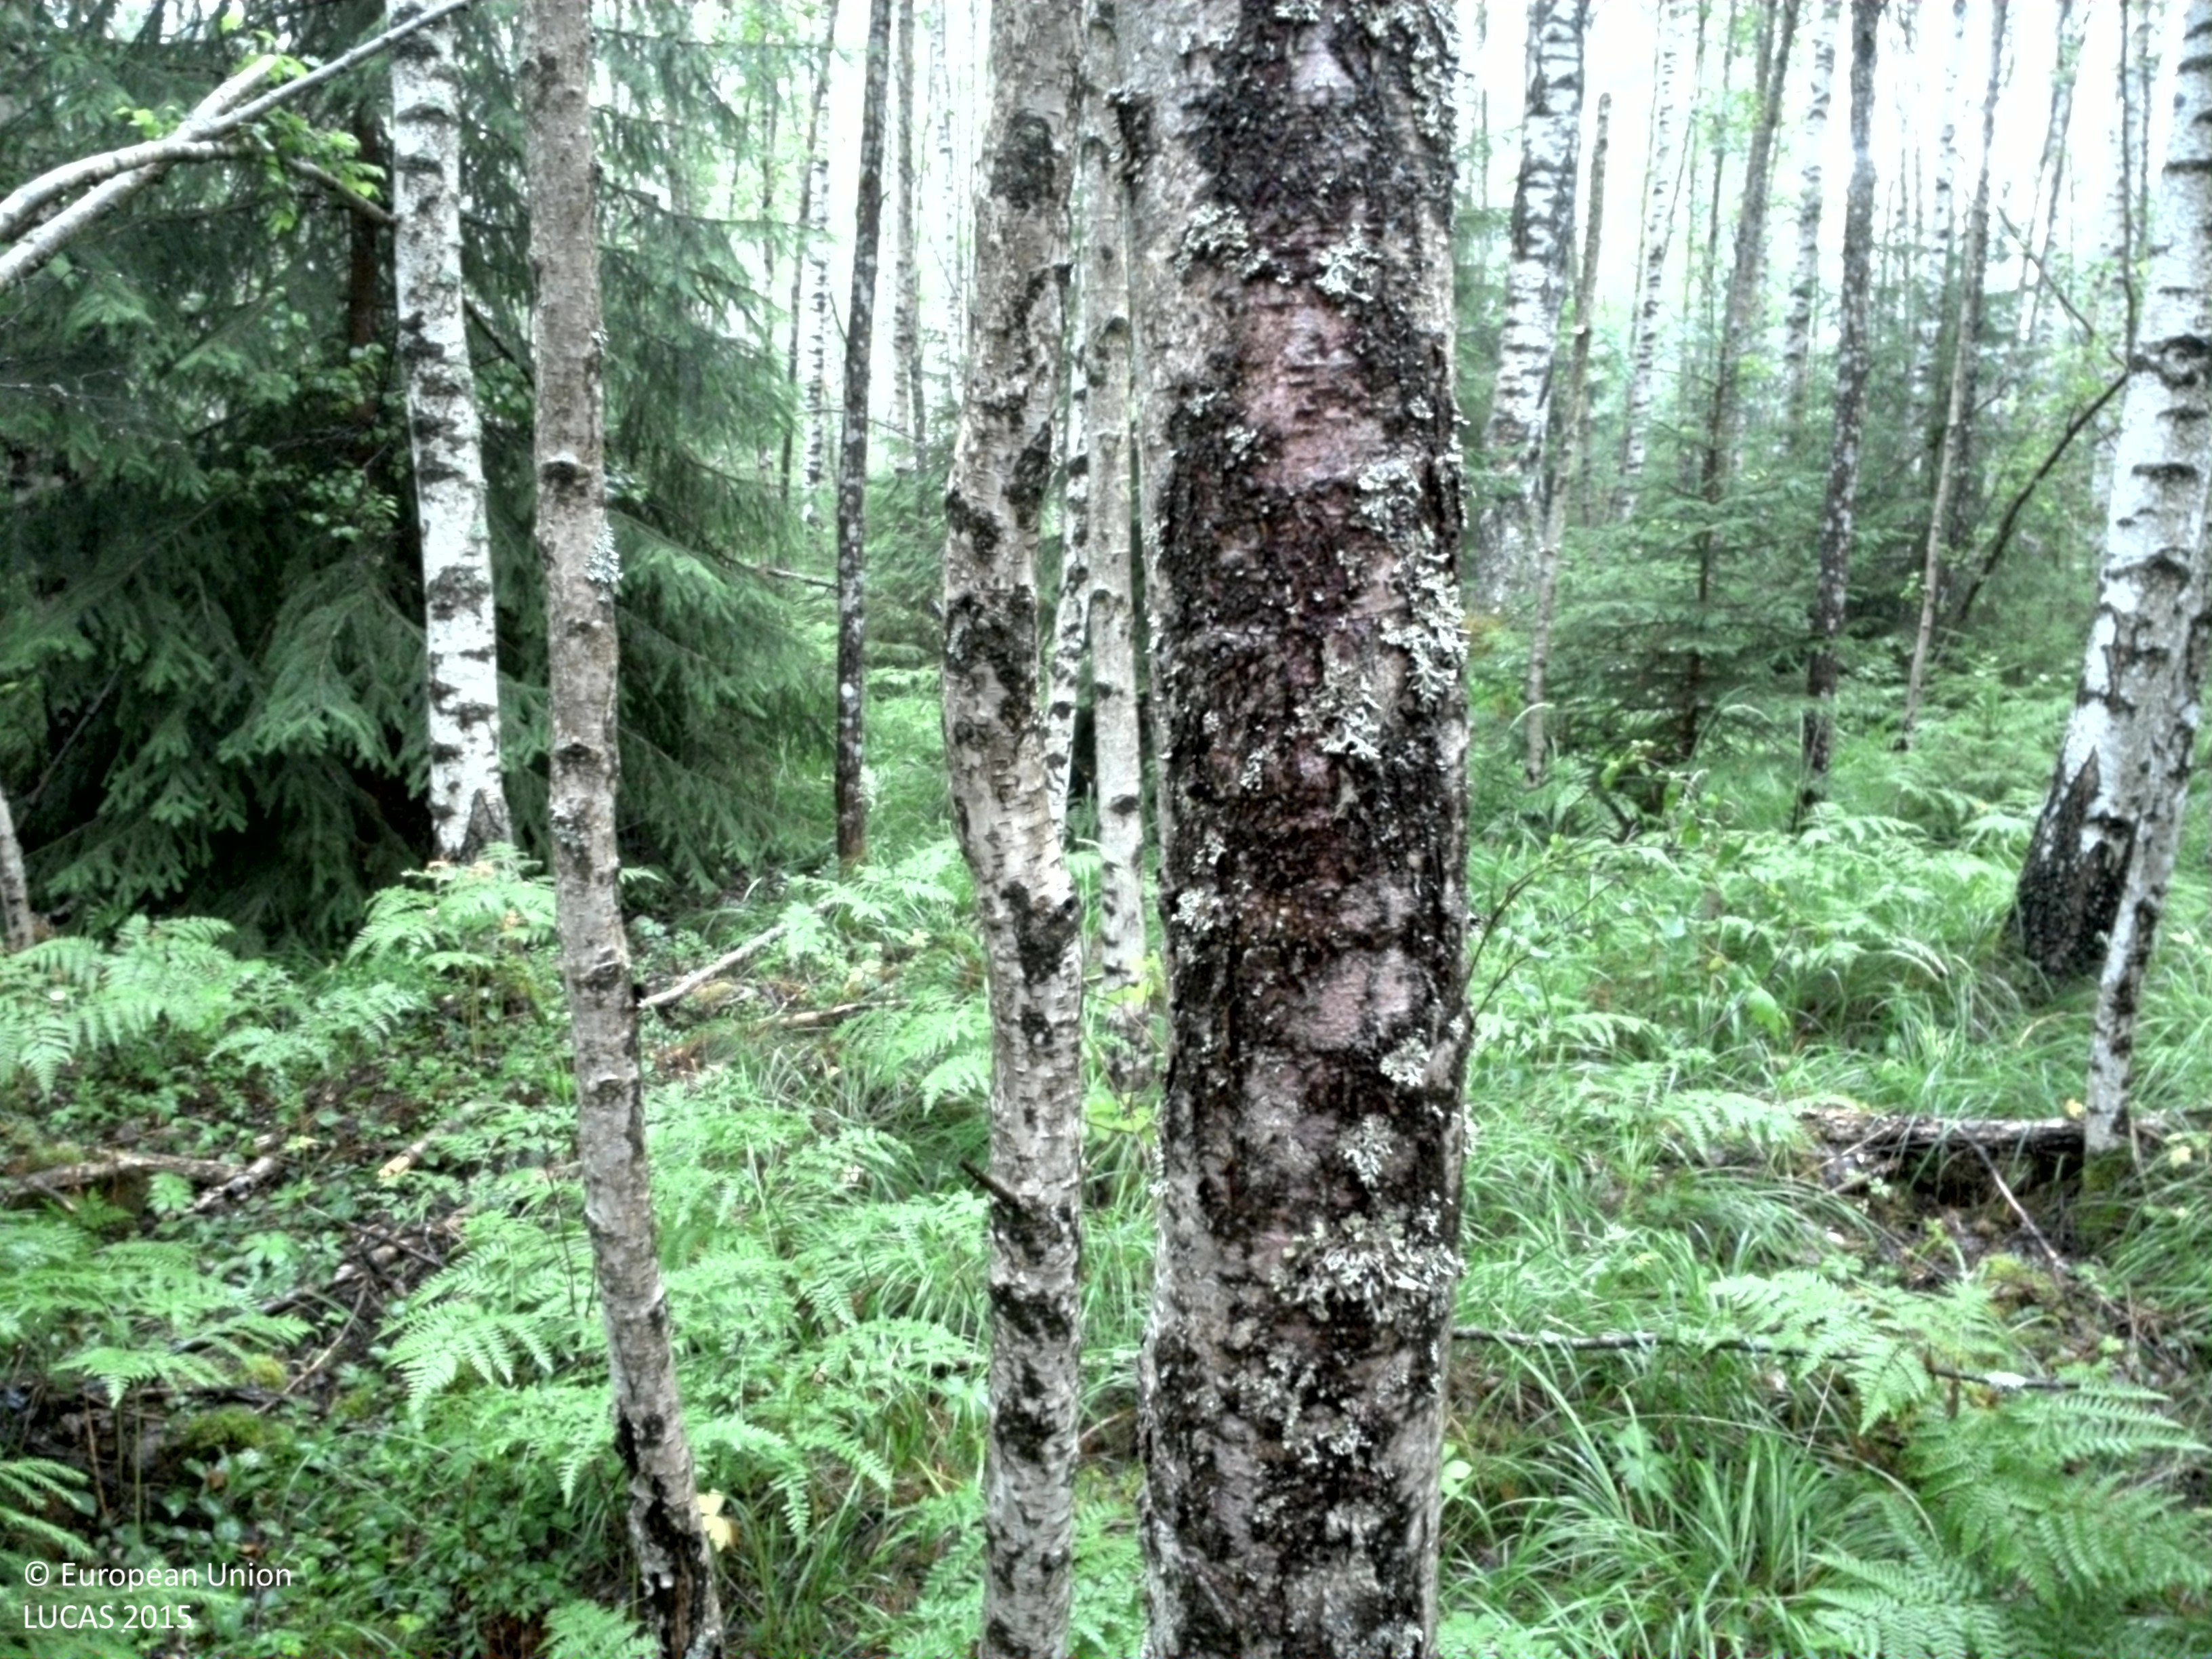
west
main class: Woodland
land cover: Other mixed woodland
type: boreal forest
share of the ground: > 75 %
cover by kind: broadleaved forest trees 50 %, coniferous forest trees 40 %, herbaceous plants 10 %
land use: Forestry
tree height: > 5 m
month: July
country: SE
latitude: 60.0871
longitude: 17.2008
